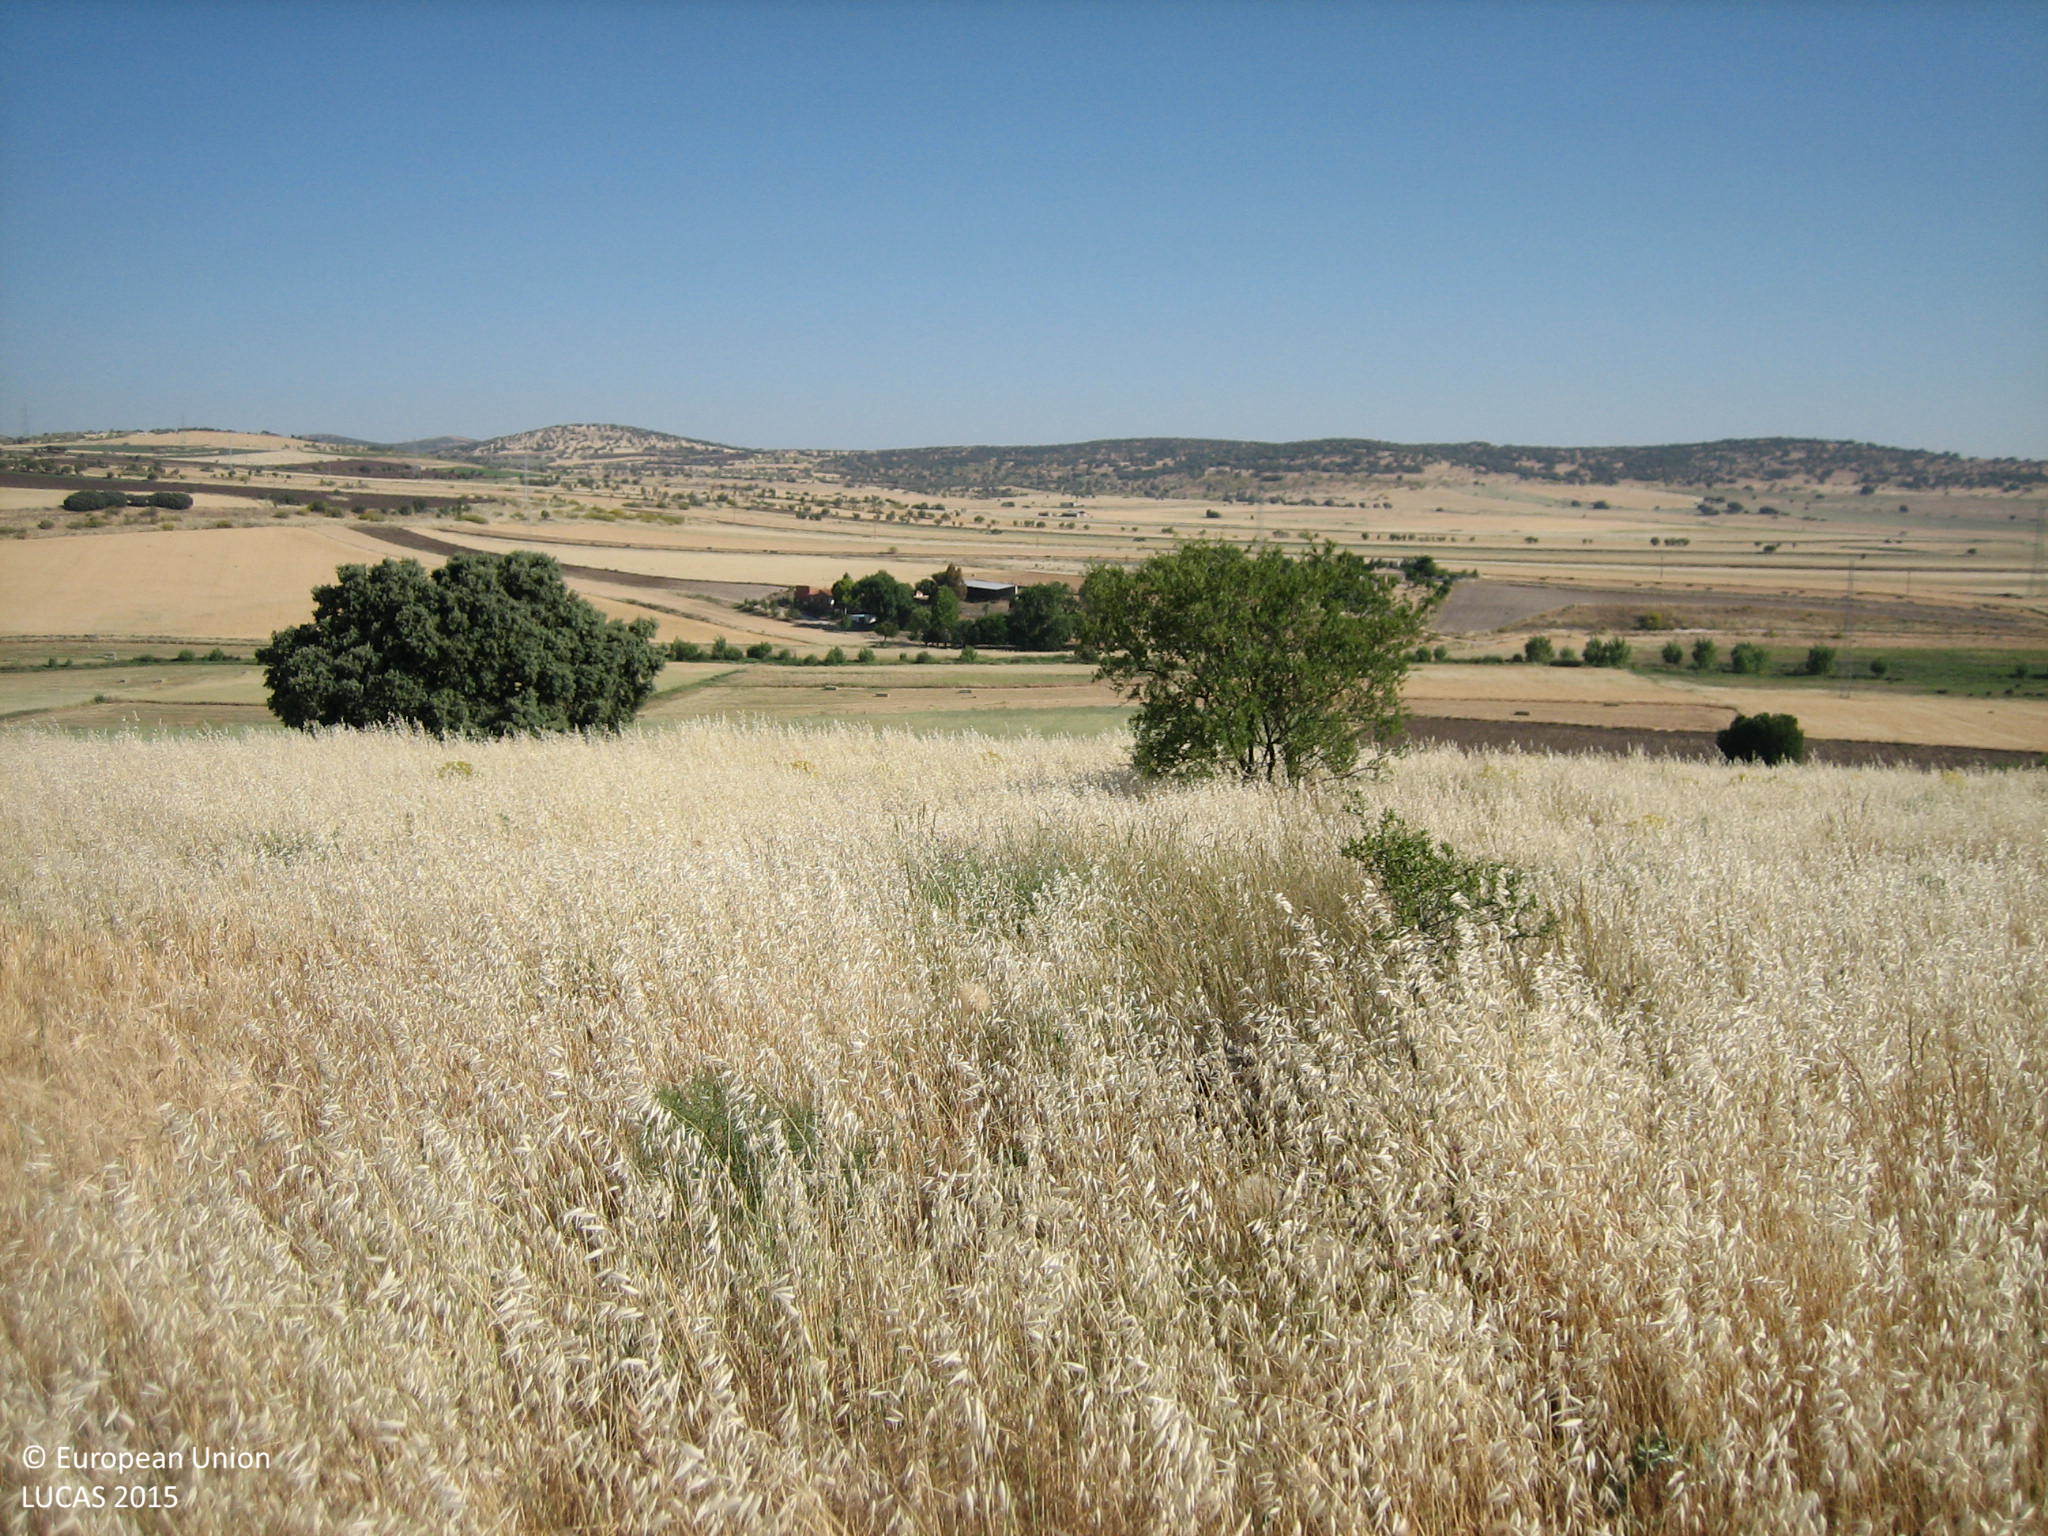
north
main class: Grassland
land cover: Spontaneously vegetated surfaces
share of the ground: > 75 %
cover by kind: herbaceous plants 95 %, shrubs 5 %
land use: Semi-natural and natural areas not in use
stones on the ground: < 10 %
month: May
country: ES
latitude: 38.9906
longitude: -4.0729
